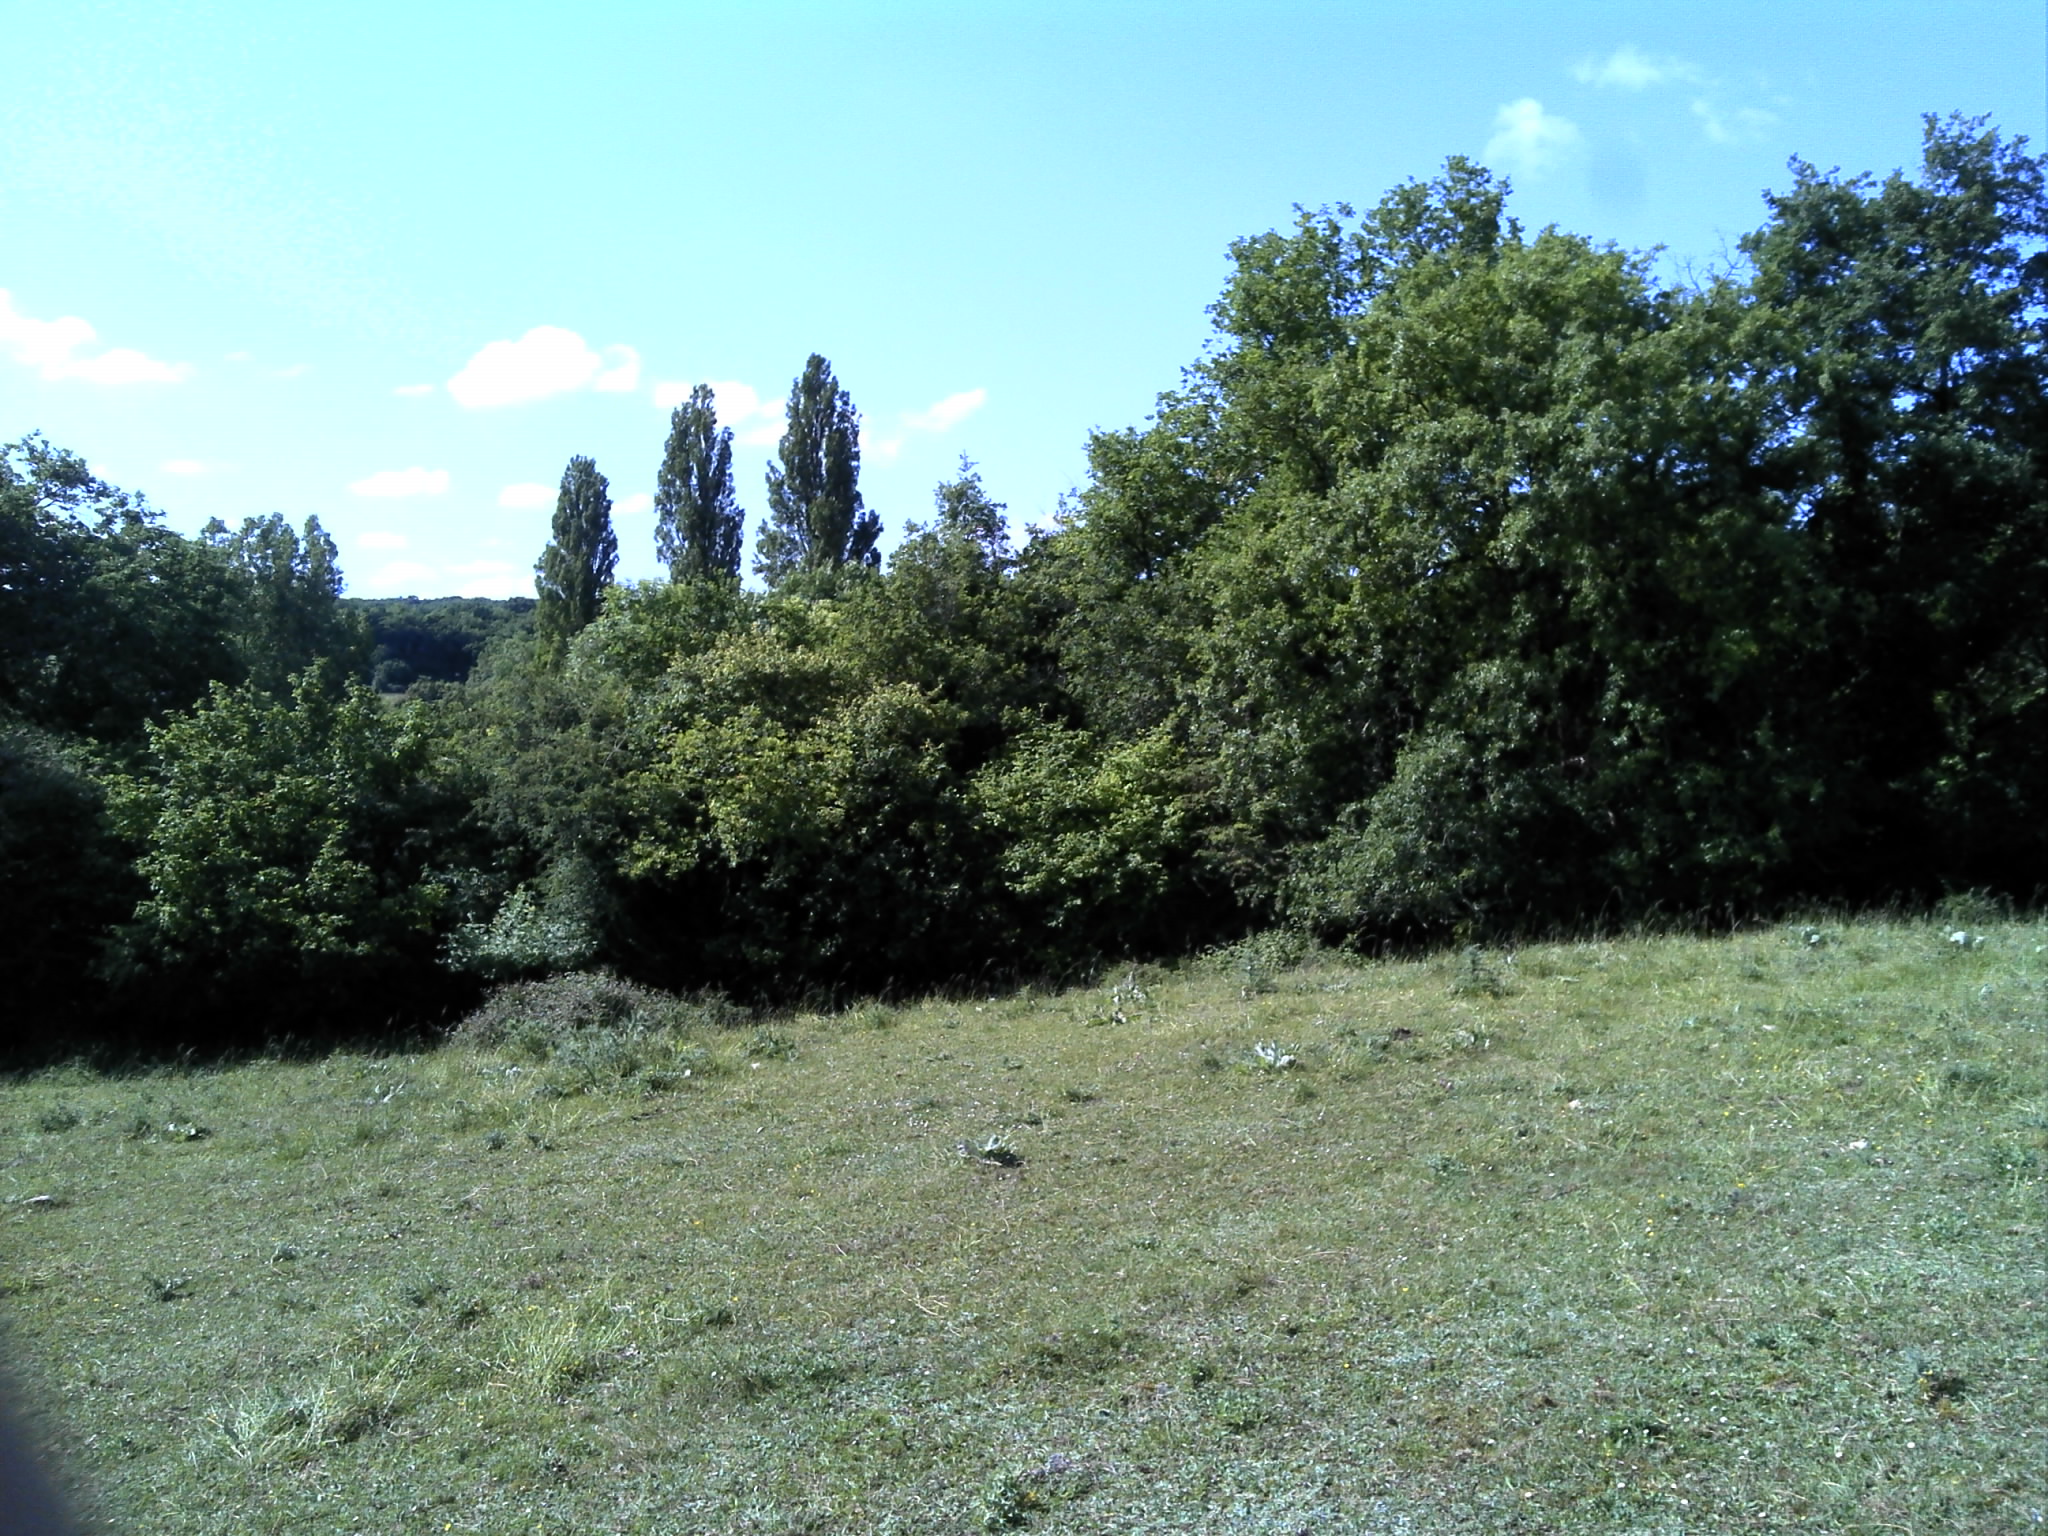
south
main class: Grassland
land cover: Grassland without tree/shrub cover
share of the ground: > 75 %
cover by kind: herbaceous plants 100 %
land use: Agriculture (excluding fallow land and kitchen gardens)
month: May
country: FR
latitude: 46.6331
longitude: 1.5645
